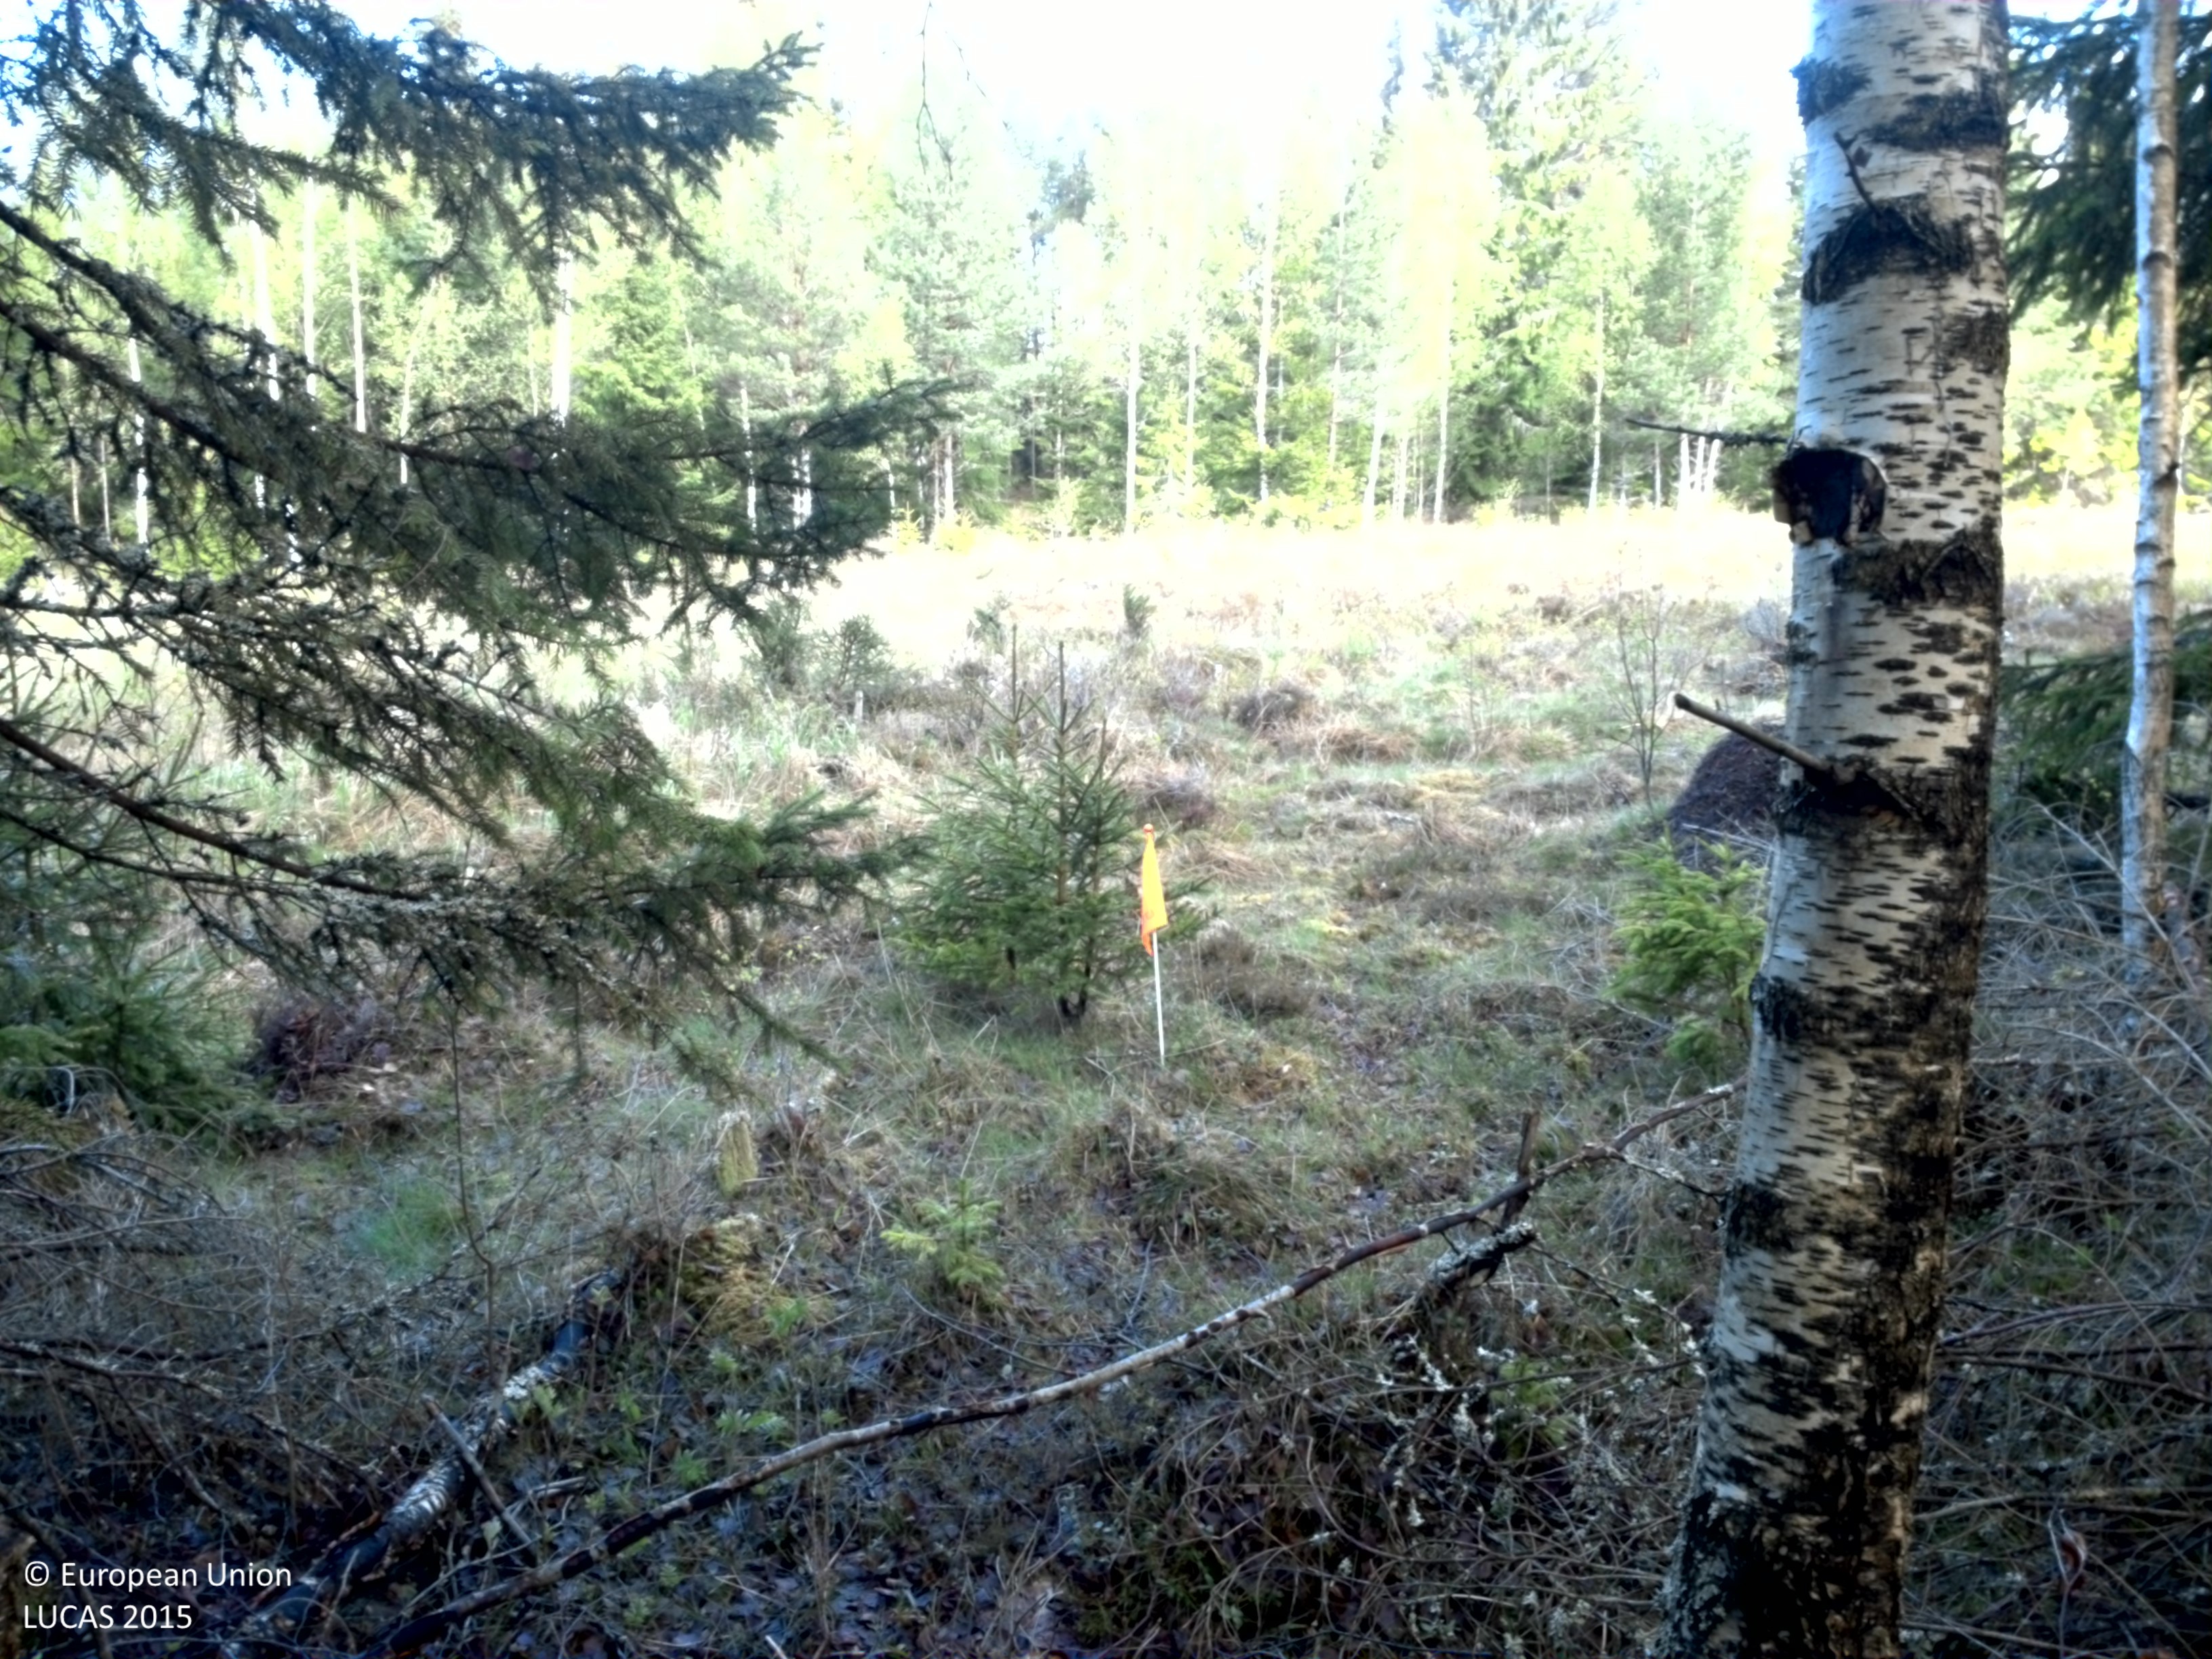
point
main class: Woodland
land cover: Broadleaved woodland
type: hemiboreal forest and nemoral coniferous forest and mixed broadleaved-coniferous forest
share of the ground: 10 - 25 %
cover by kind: herbaceous plants 50 %, shrubs 30 %, broadleaved forest trees 10 %, lichens and mosses 10 %
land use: Electricity, gas and thermal power distribution
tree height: < 5 m
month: May
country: SE
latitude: 59.2905
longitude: 14.1524
